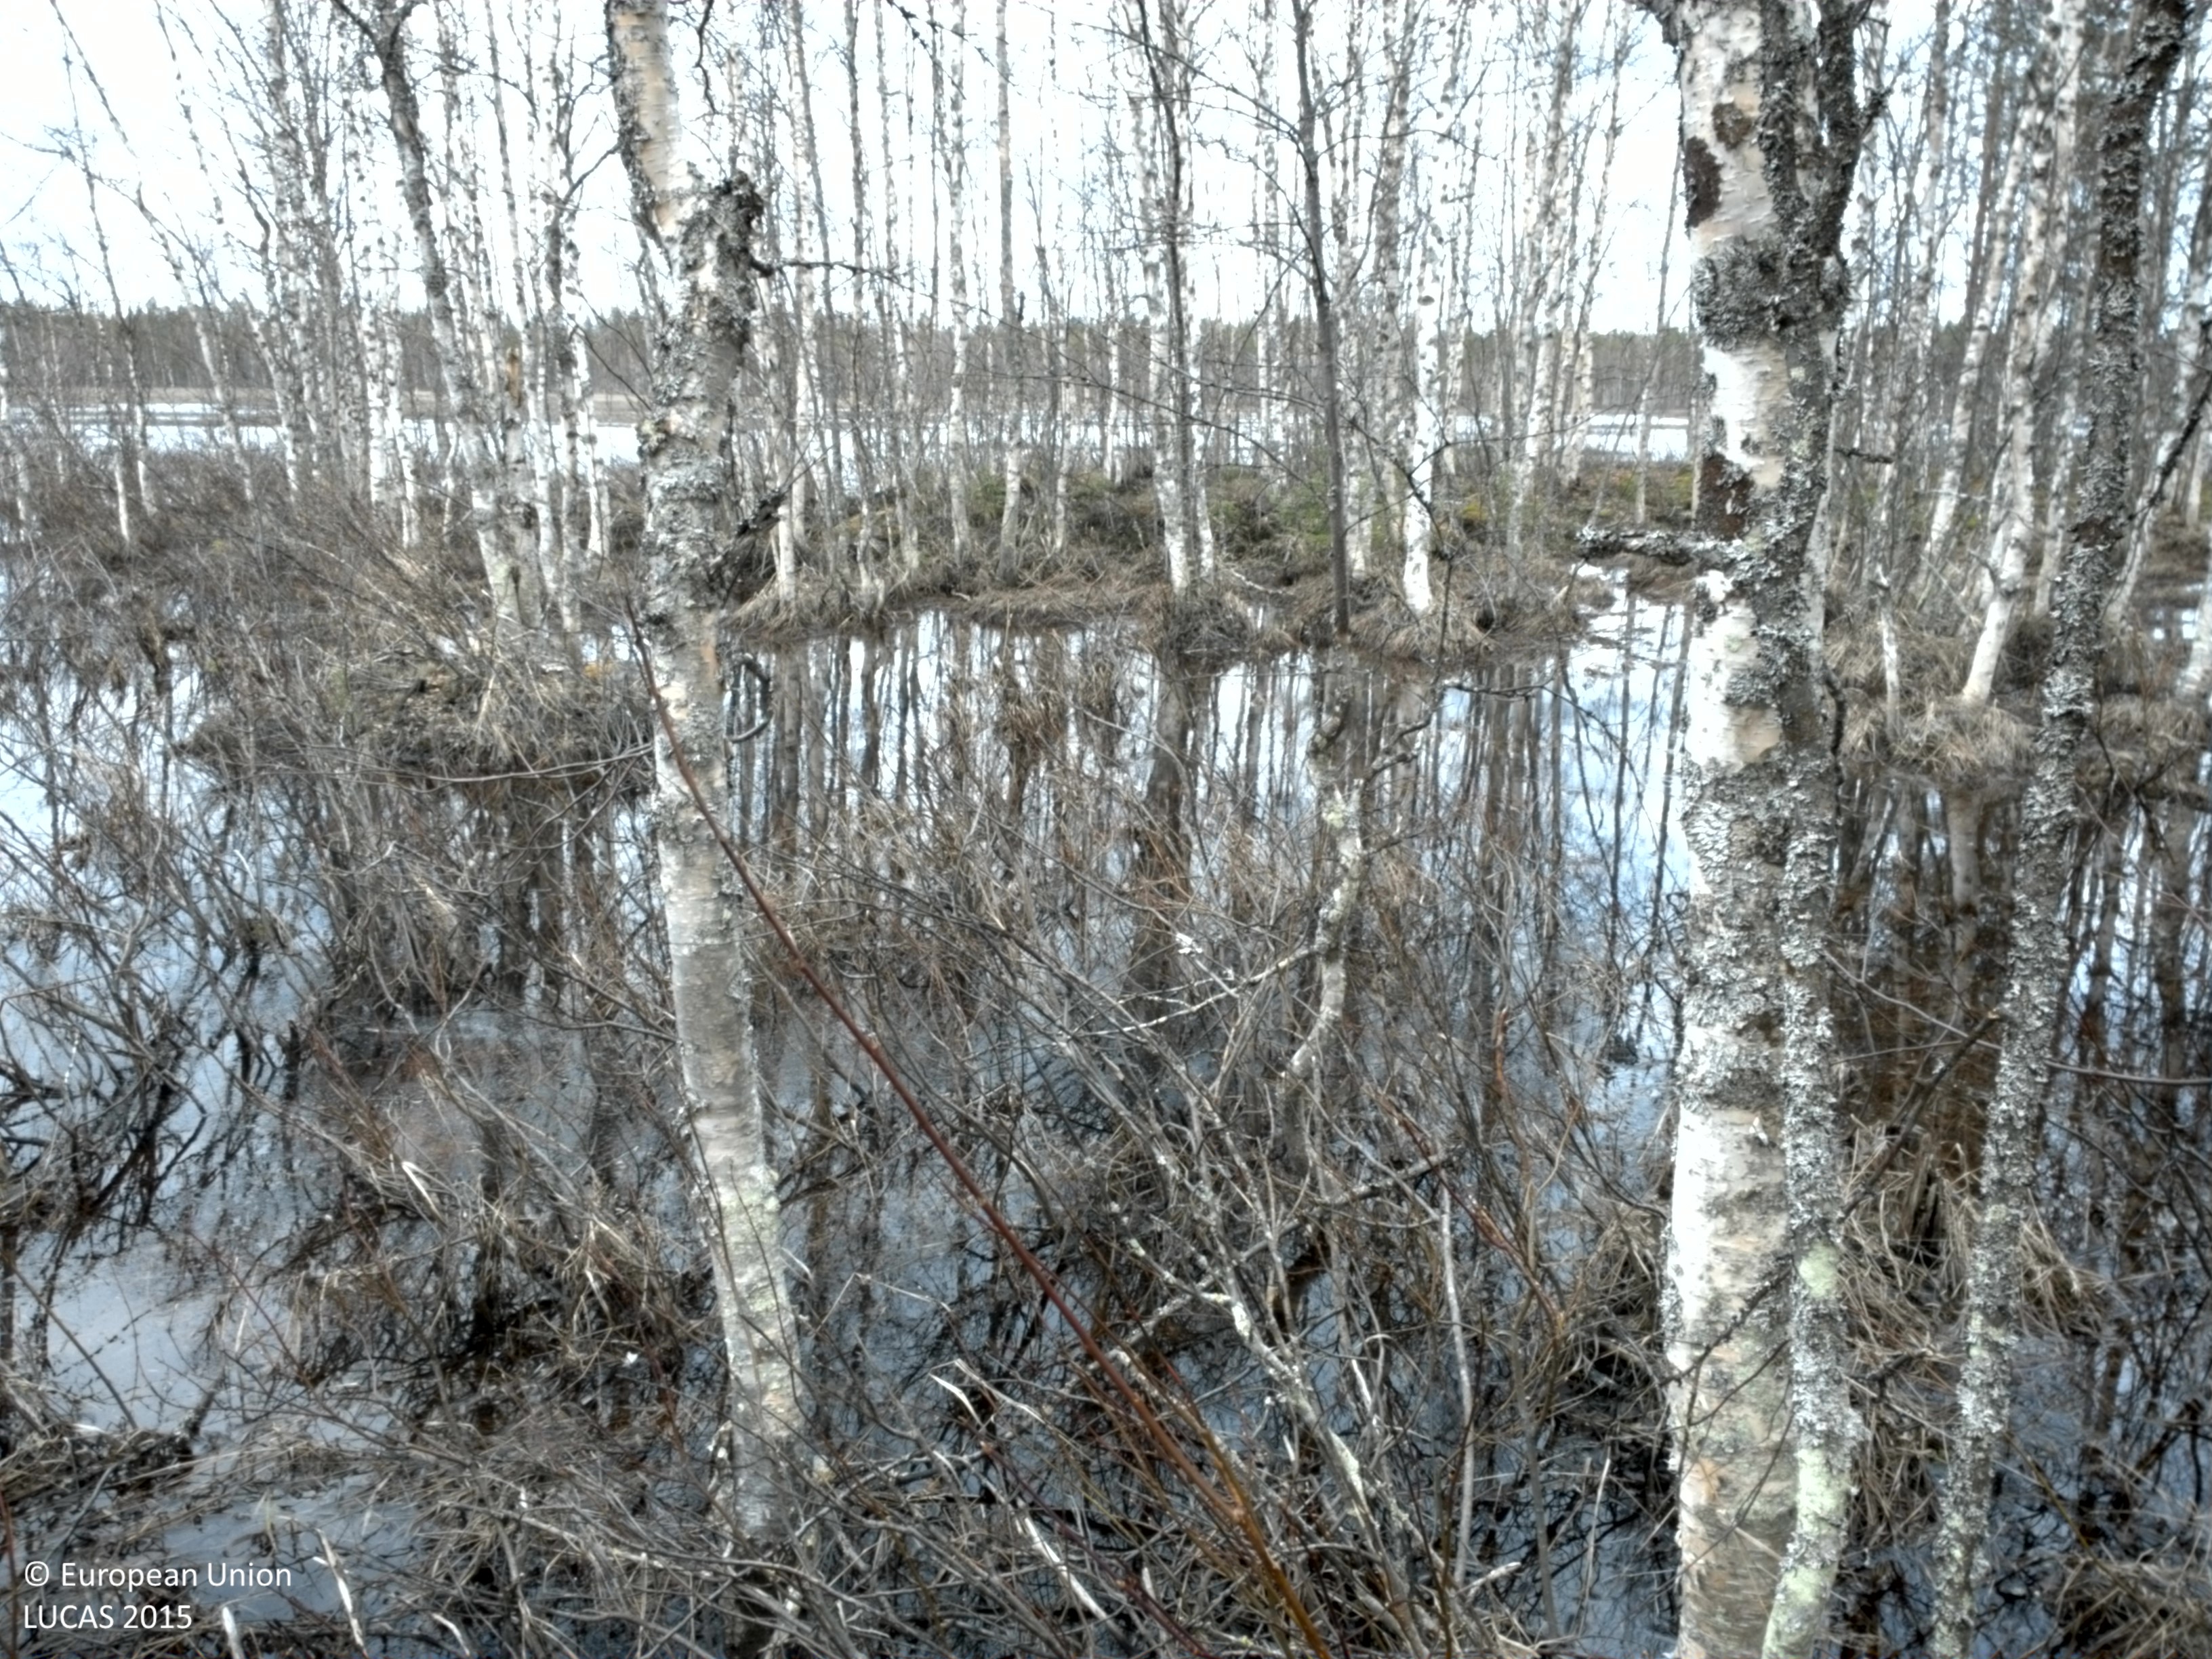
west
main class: Woodland
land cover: Broadleaved woodland
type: mire and swamp forests
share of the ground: 50 - 75 %
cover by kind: broadleaved forest trees 60 %, shrubs 15 %, herbaceous plants 10 %
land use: Semi-natural and natural areas not in use
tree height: > 5 m
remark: Temporary flooded
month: May
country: SE
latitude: 65.8939
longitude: 23.3086
